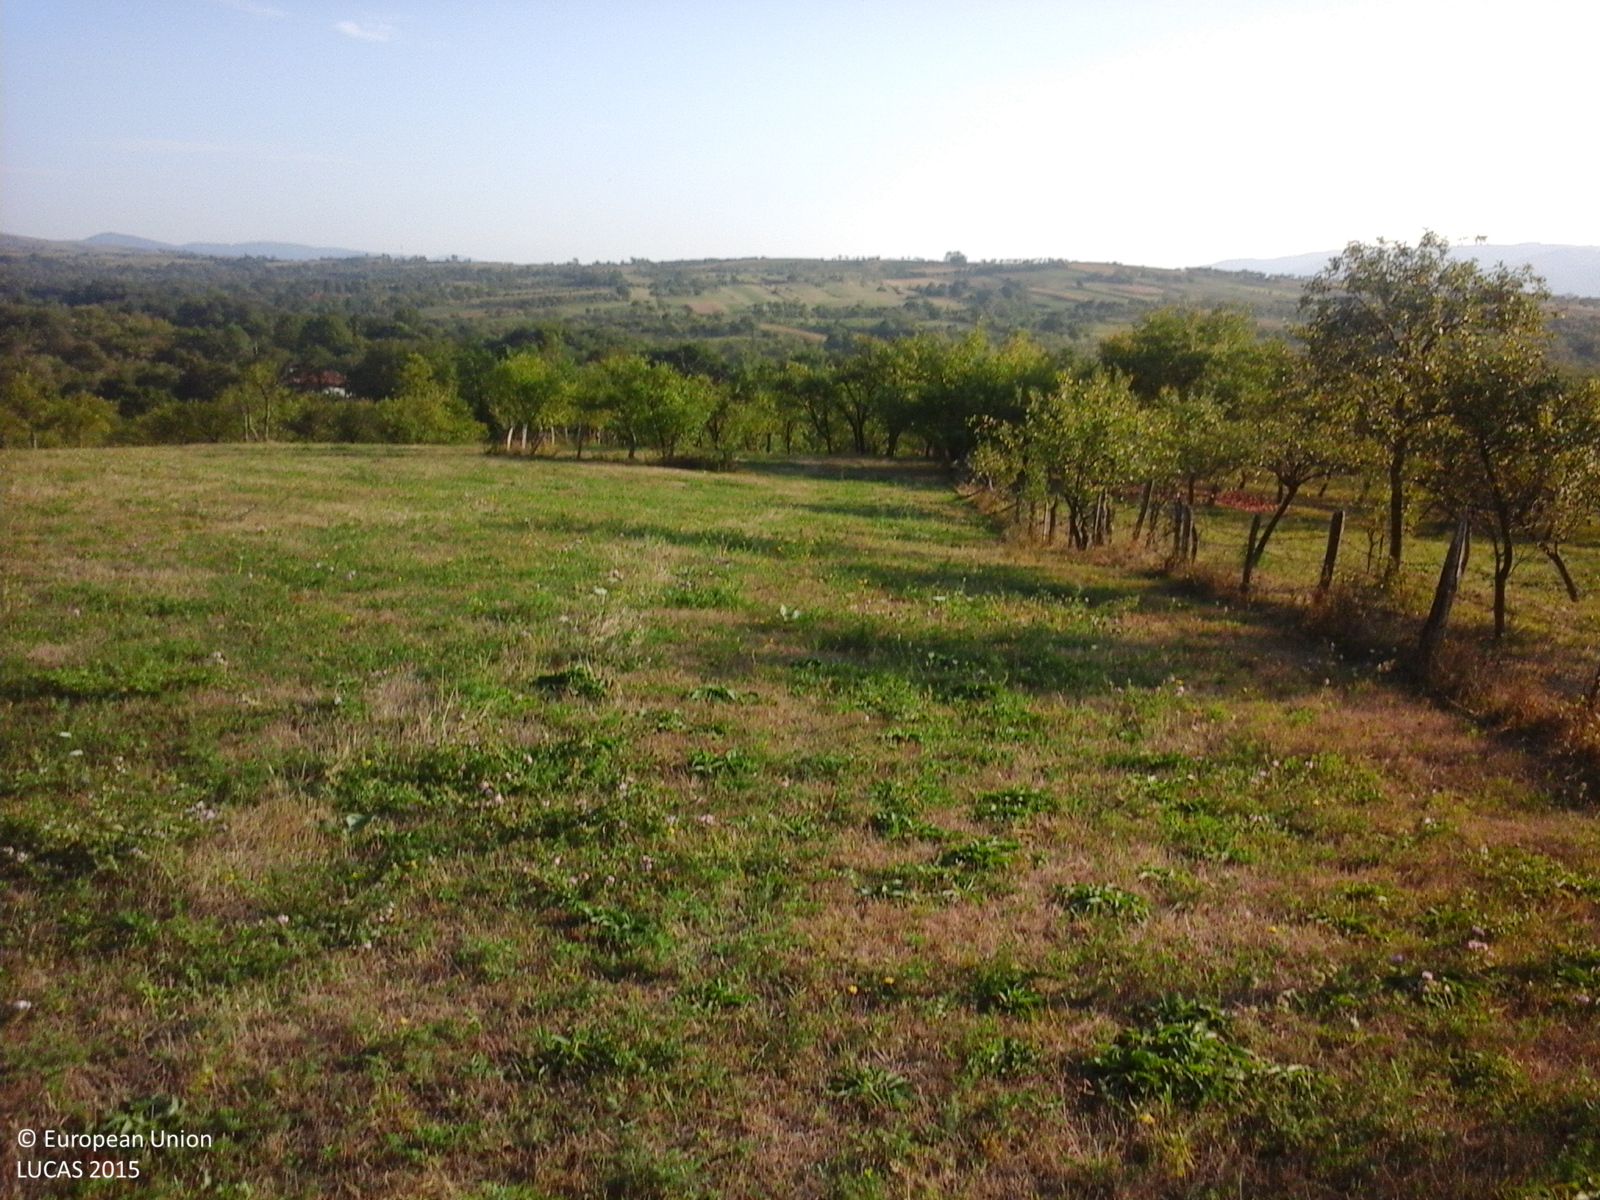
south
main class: Cropland
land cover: Other fruit trees and berries
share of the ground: 50 - 75 %
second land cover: Grassland without tree/shrub cover
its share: > 75 %
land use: Agriculture (excluding fallow land and kitchen gardens)
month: September
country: RO
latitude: 45.2898
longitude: 22.3200
